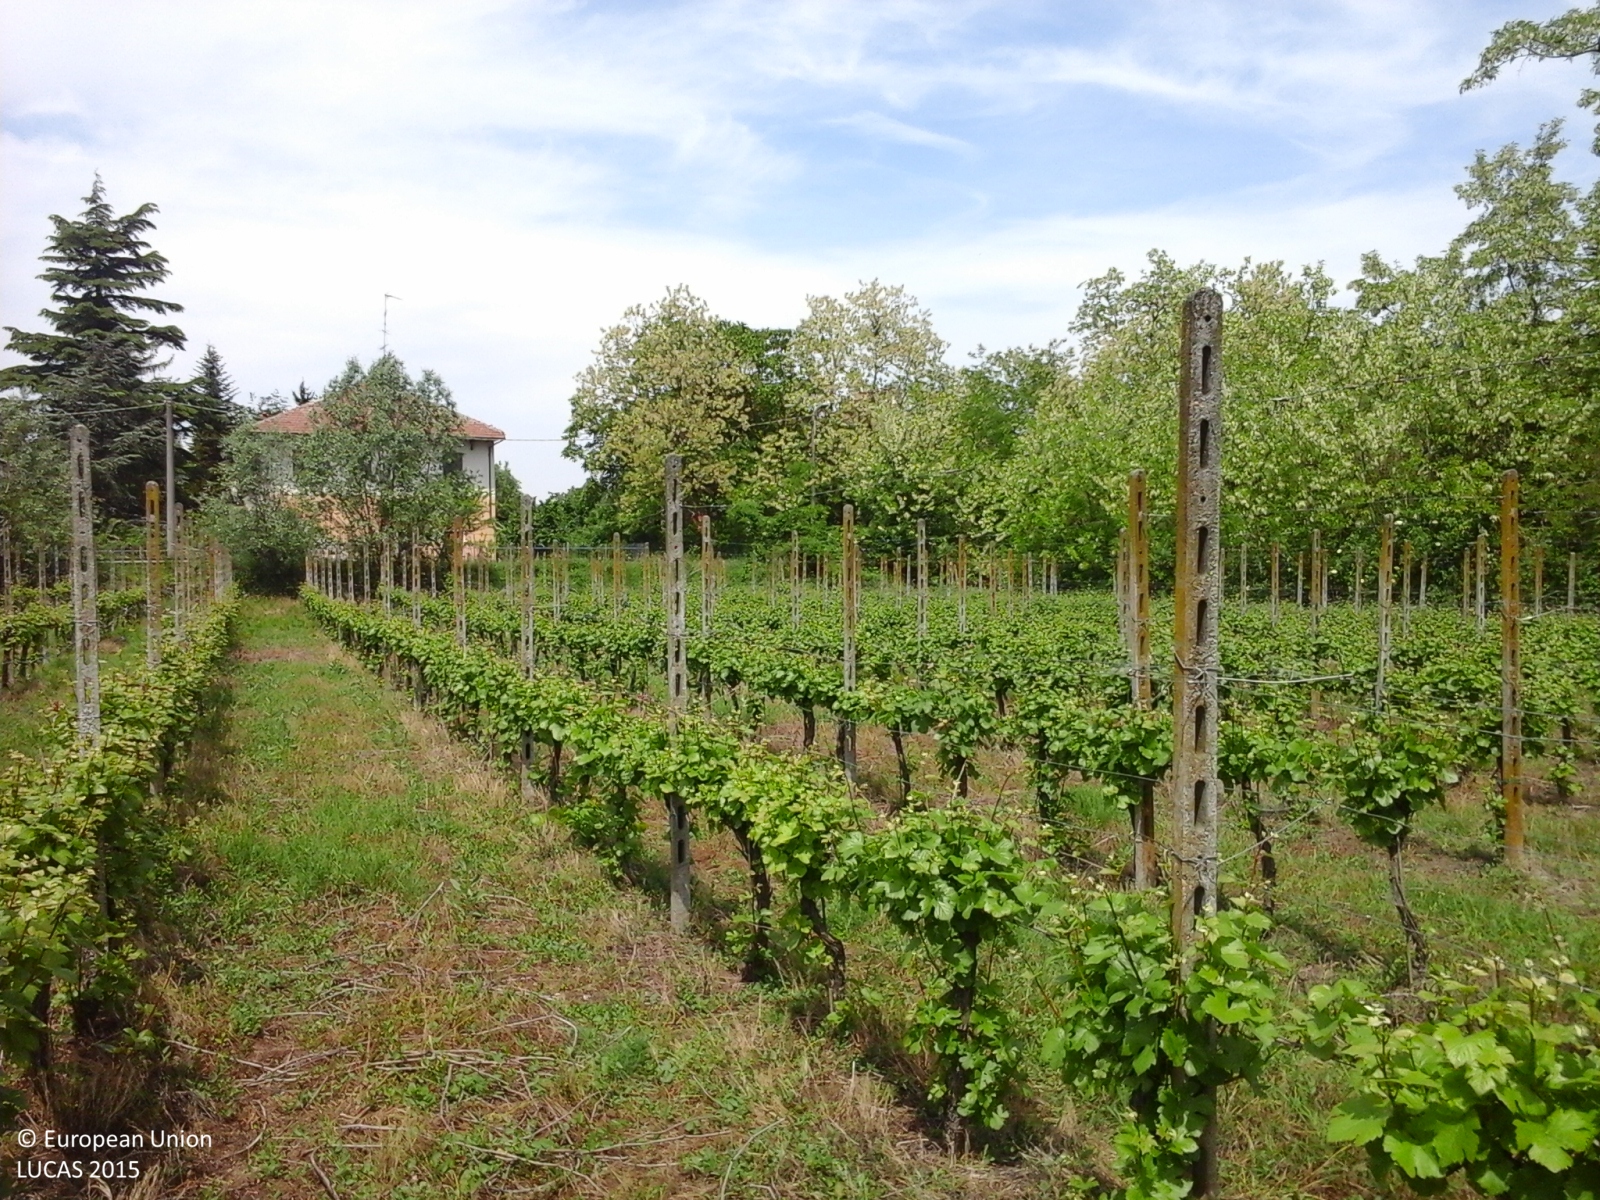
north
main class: Cropland
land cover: Vineyards
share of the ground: 50 - 75 %
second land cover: Grassland without tree/shrub cover
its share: > 75 %
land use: Agriculture (excluding fallow land and kitchen gardens)
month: May
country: IT
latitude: 45.0145
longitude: 9.1768
